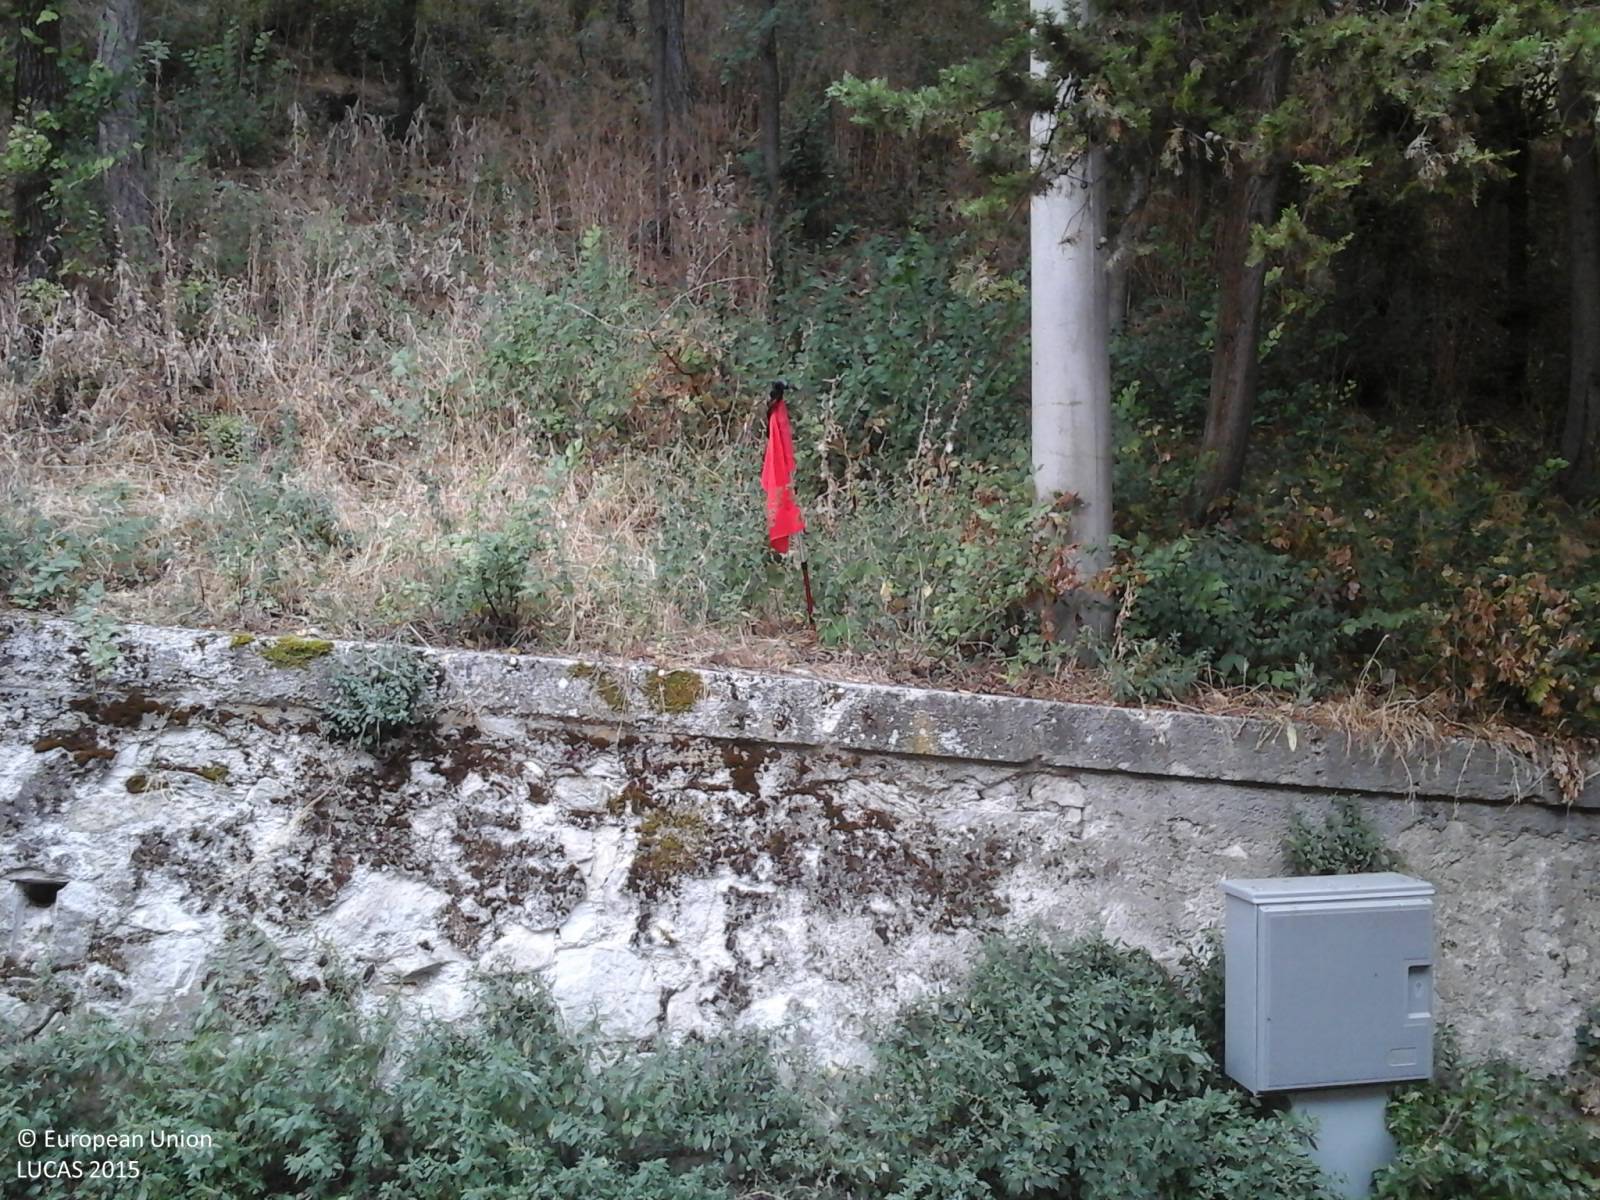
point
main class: Woodland
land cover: Broadleaved woodland
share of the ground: > 75 %
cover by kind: broadleaved forest trees 95 %, coniferous forest trees 5 %
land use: Amenities, museums, leisure
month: July
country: IT
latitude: 42.3595
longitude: 13.4734
